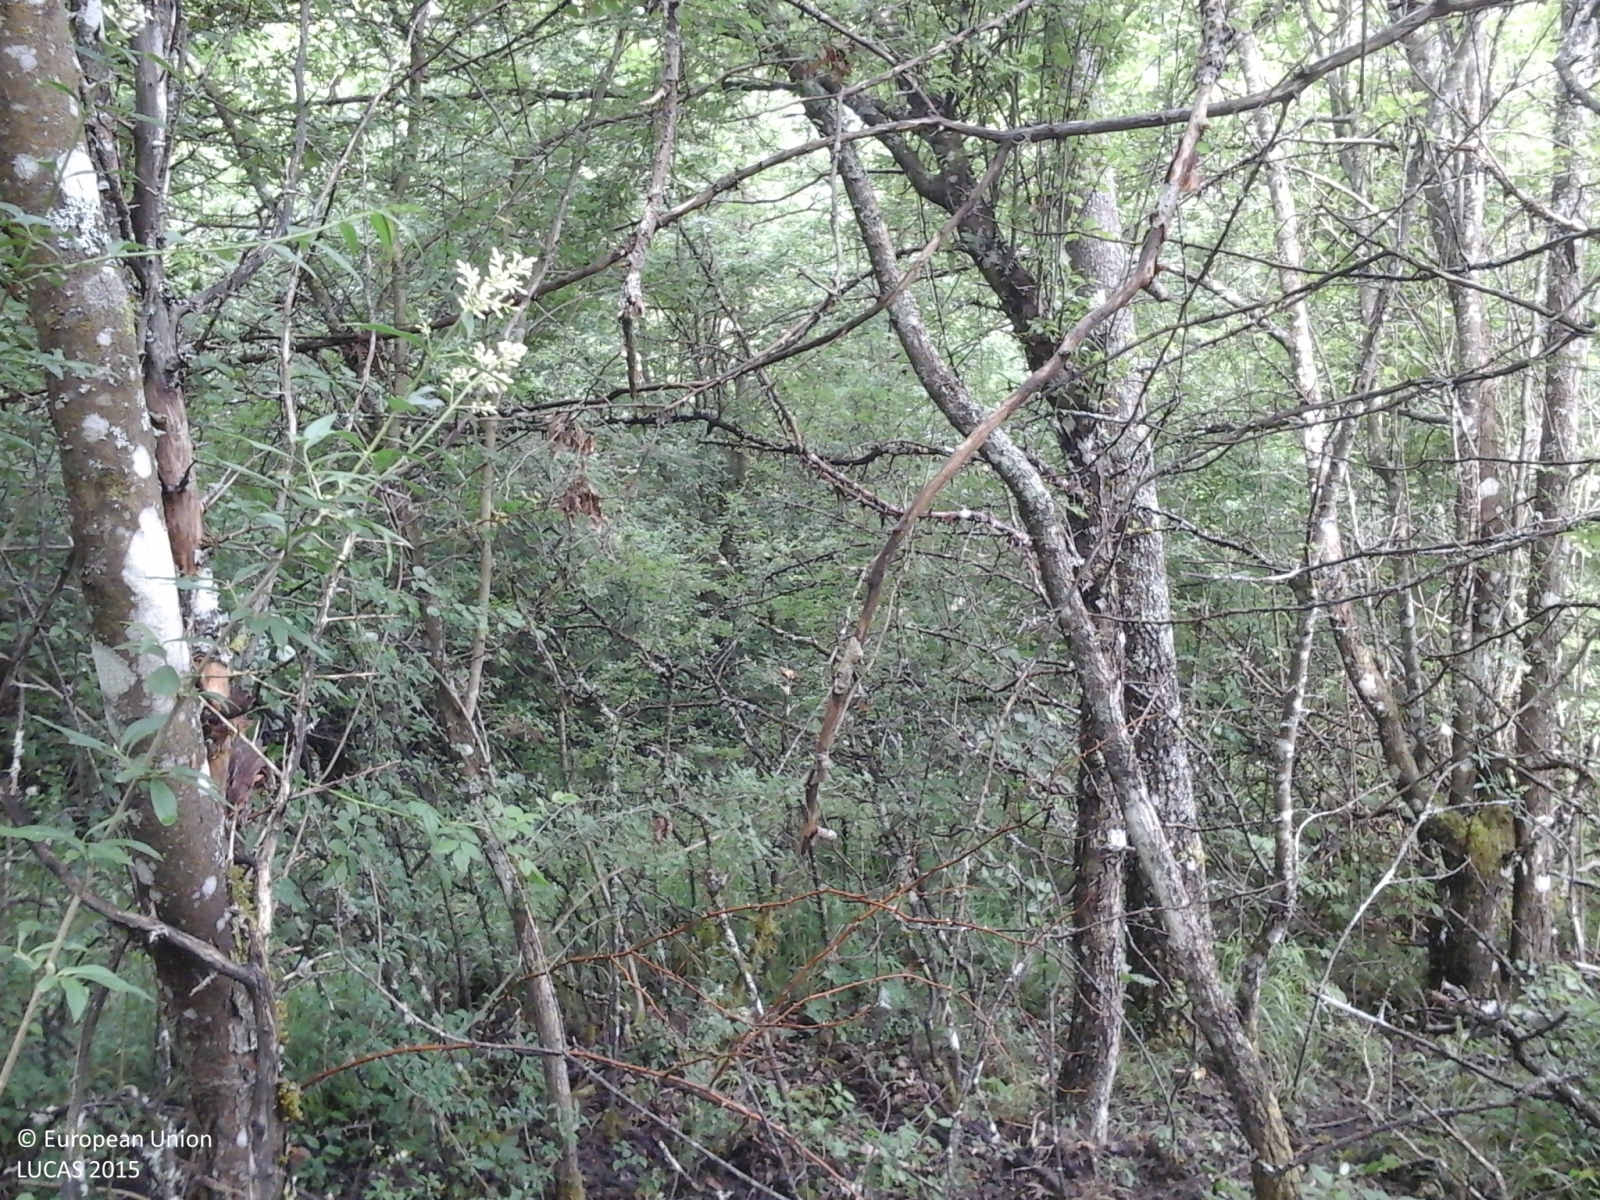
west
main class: Woodland
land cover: Broadleaved woodland
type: thermophilous deciduous forest
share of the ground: > 75 %
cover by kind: broadleaved forest trees 100 %
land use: Forestry
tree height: > 5 m
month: June
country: IT
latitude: 44.6562
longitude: 9.5596
